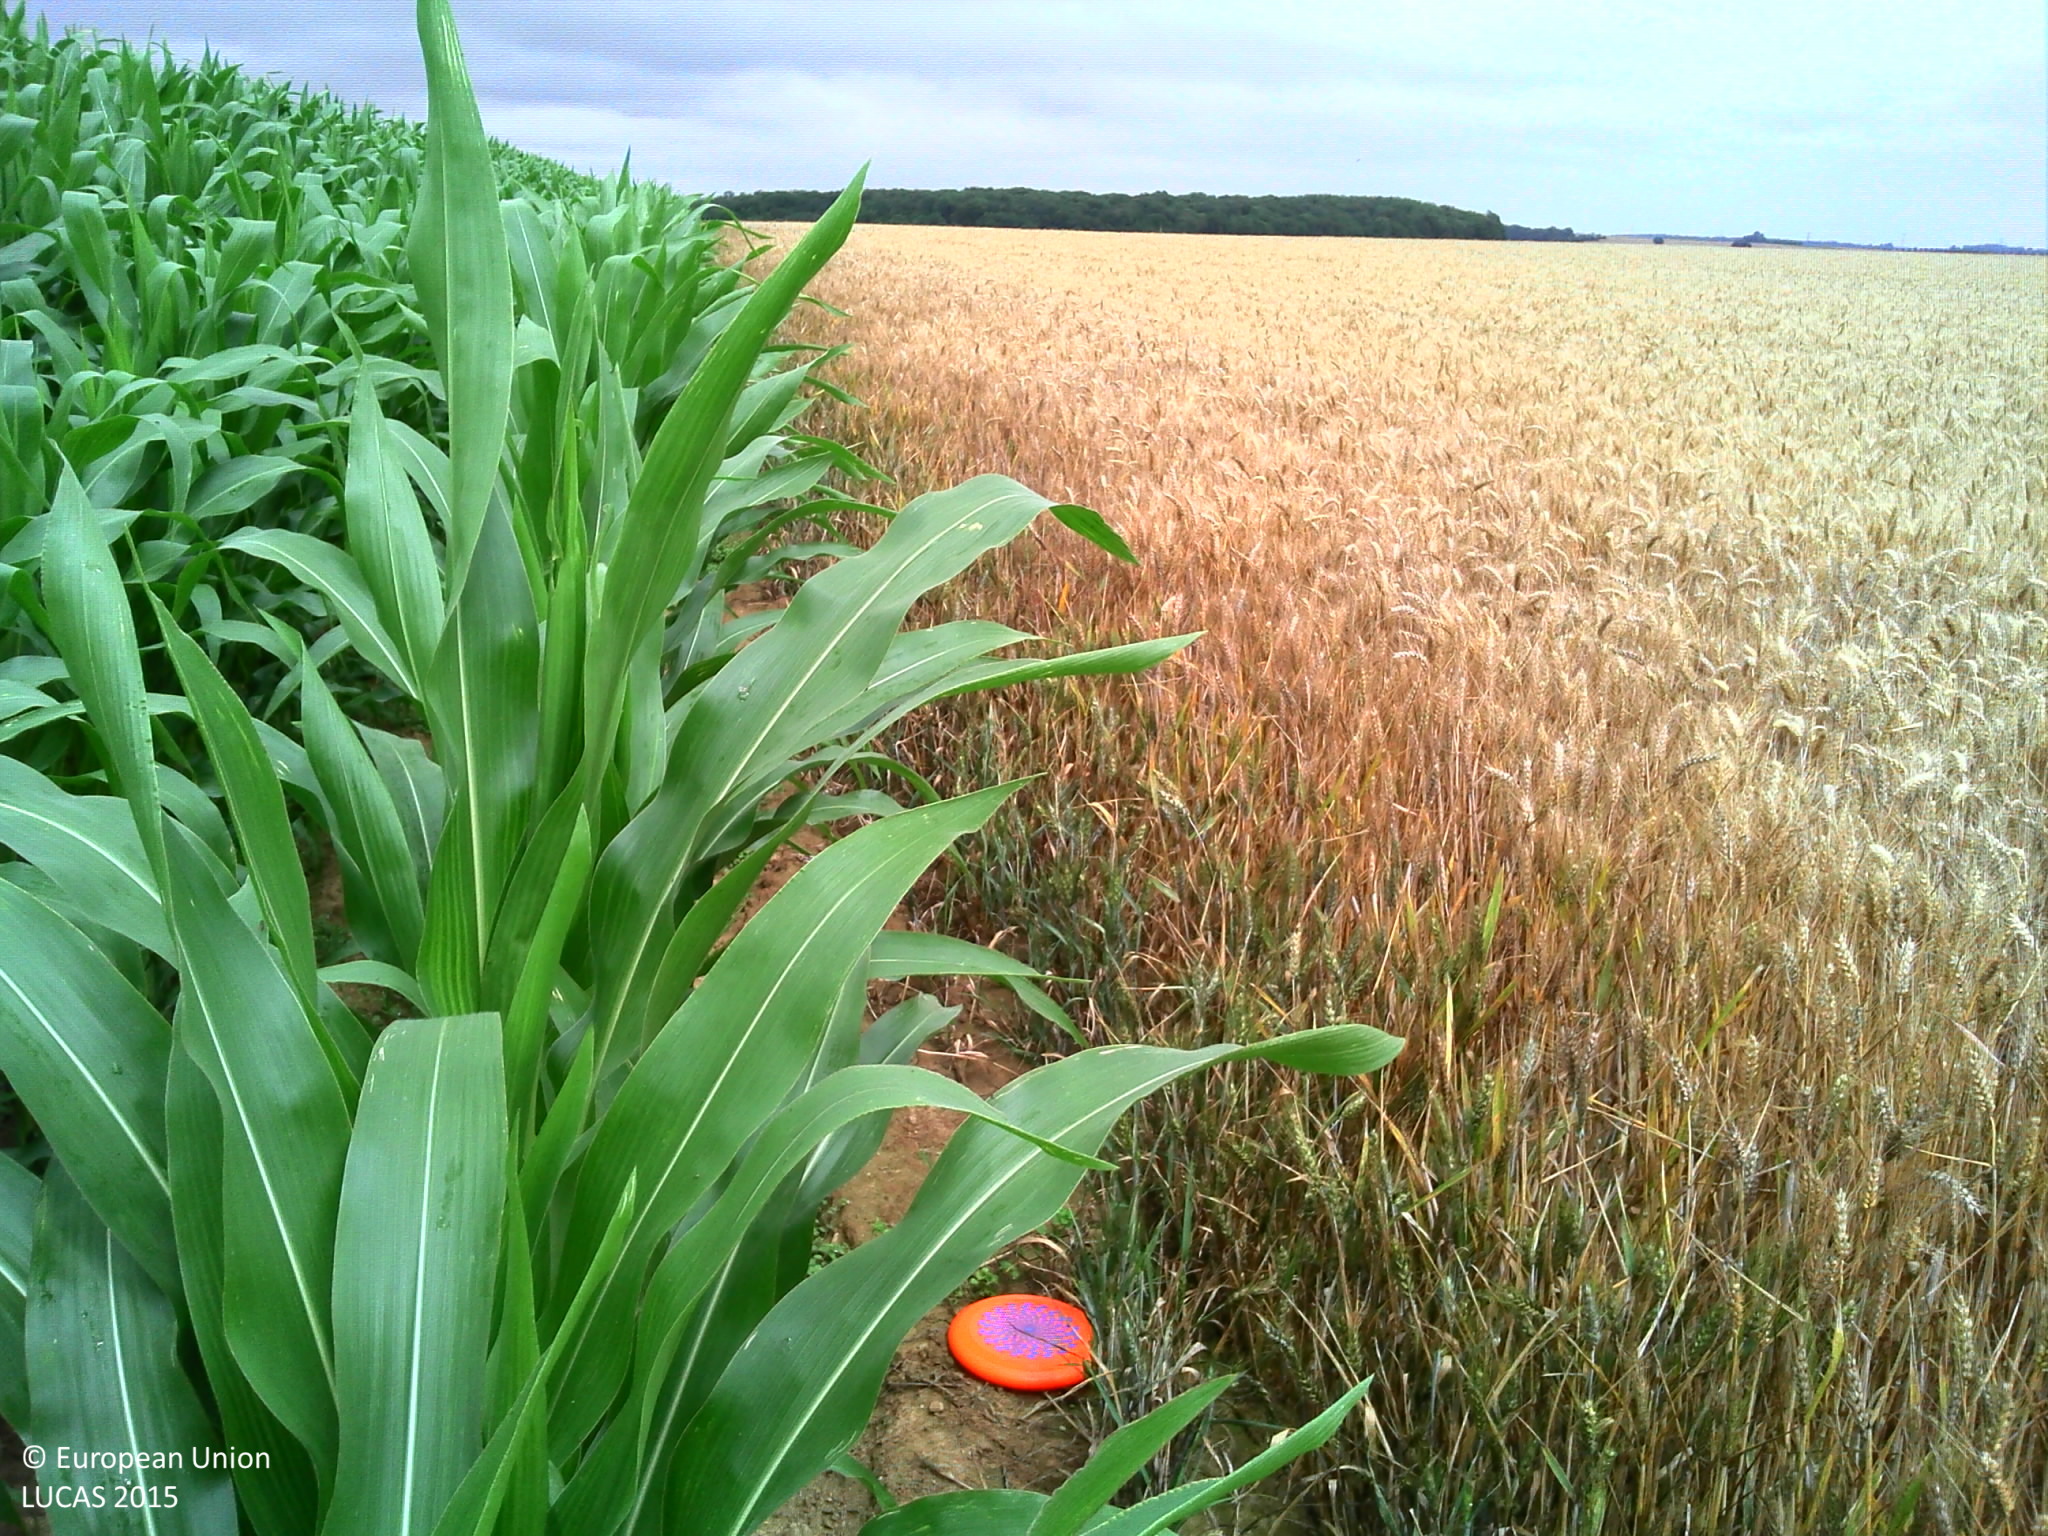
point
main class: Cropland
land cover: Maize
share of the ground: > 75 %
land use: Agriculture (excluding fallow land and kitchen gardens)
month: July
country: FR
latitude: 50.1198
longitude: 2.5332
